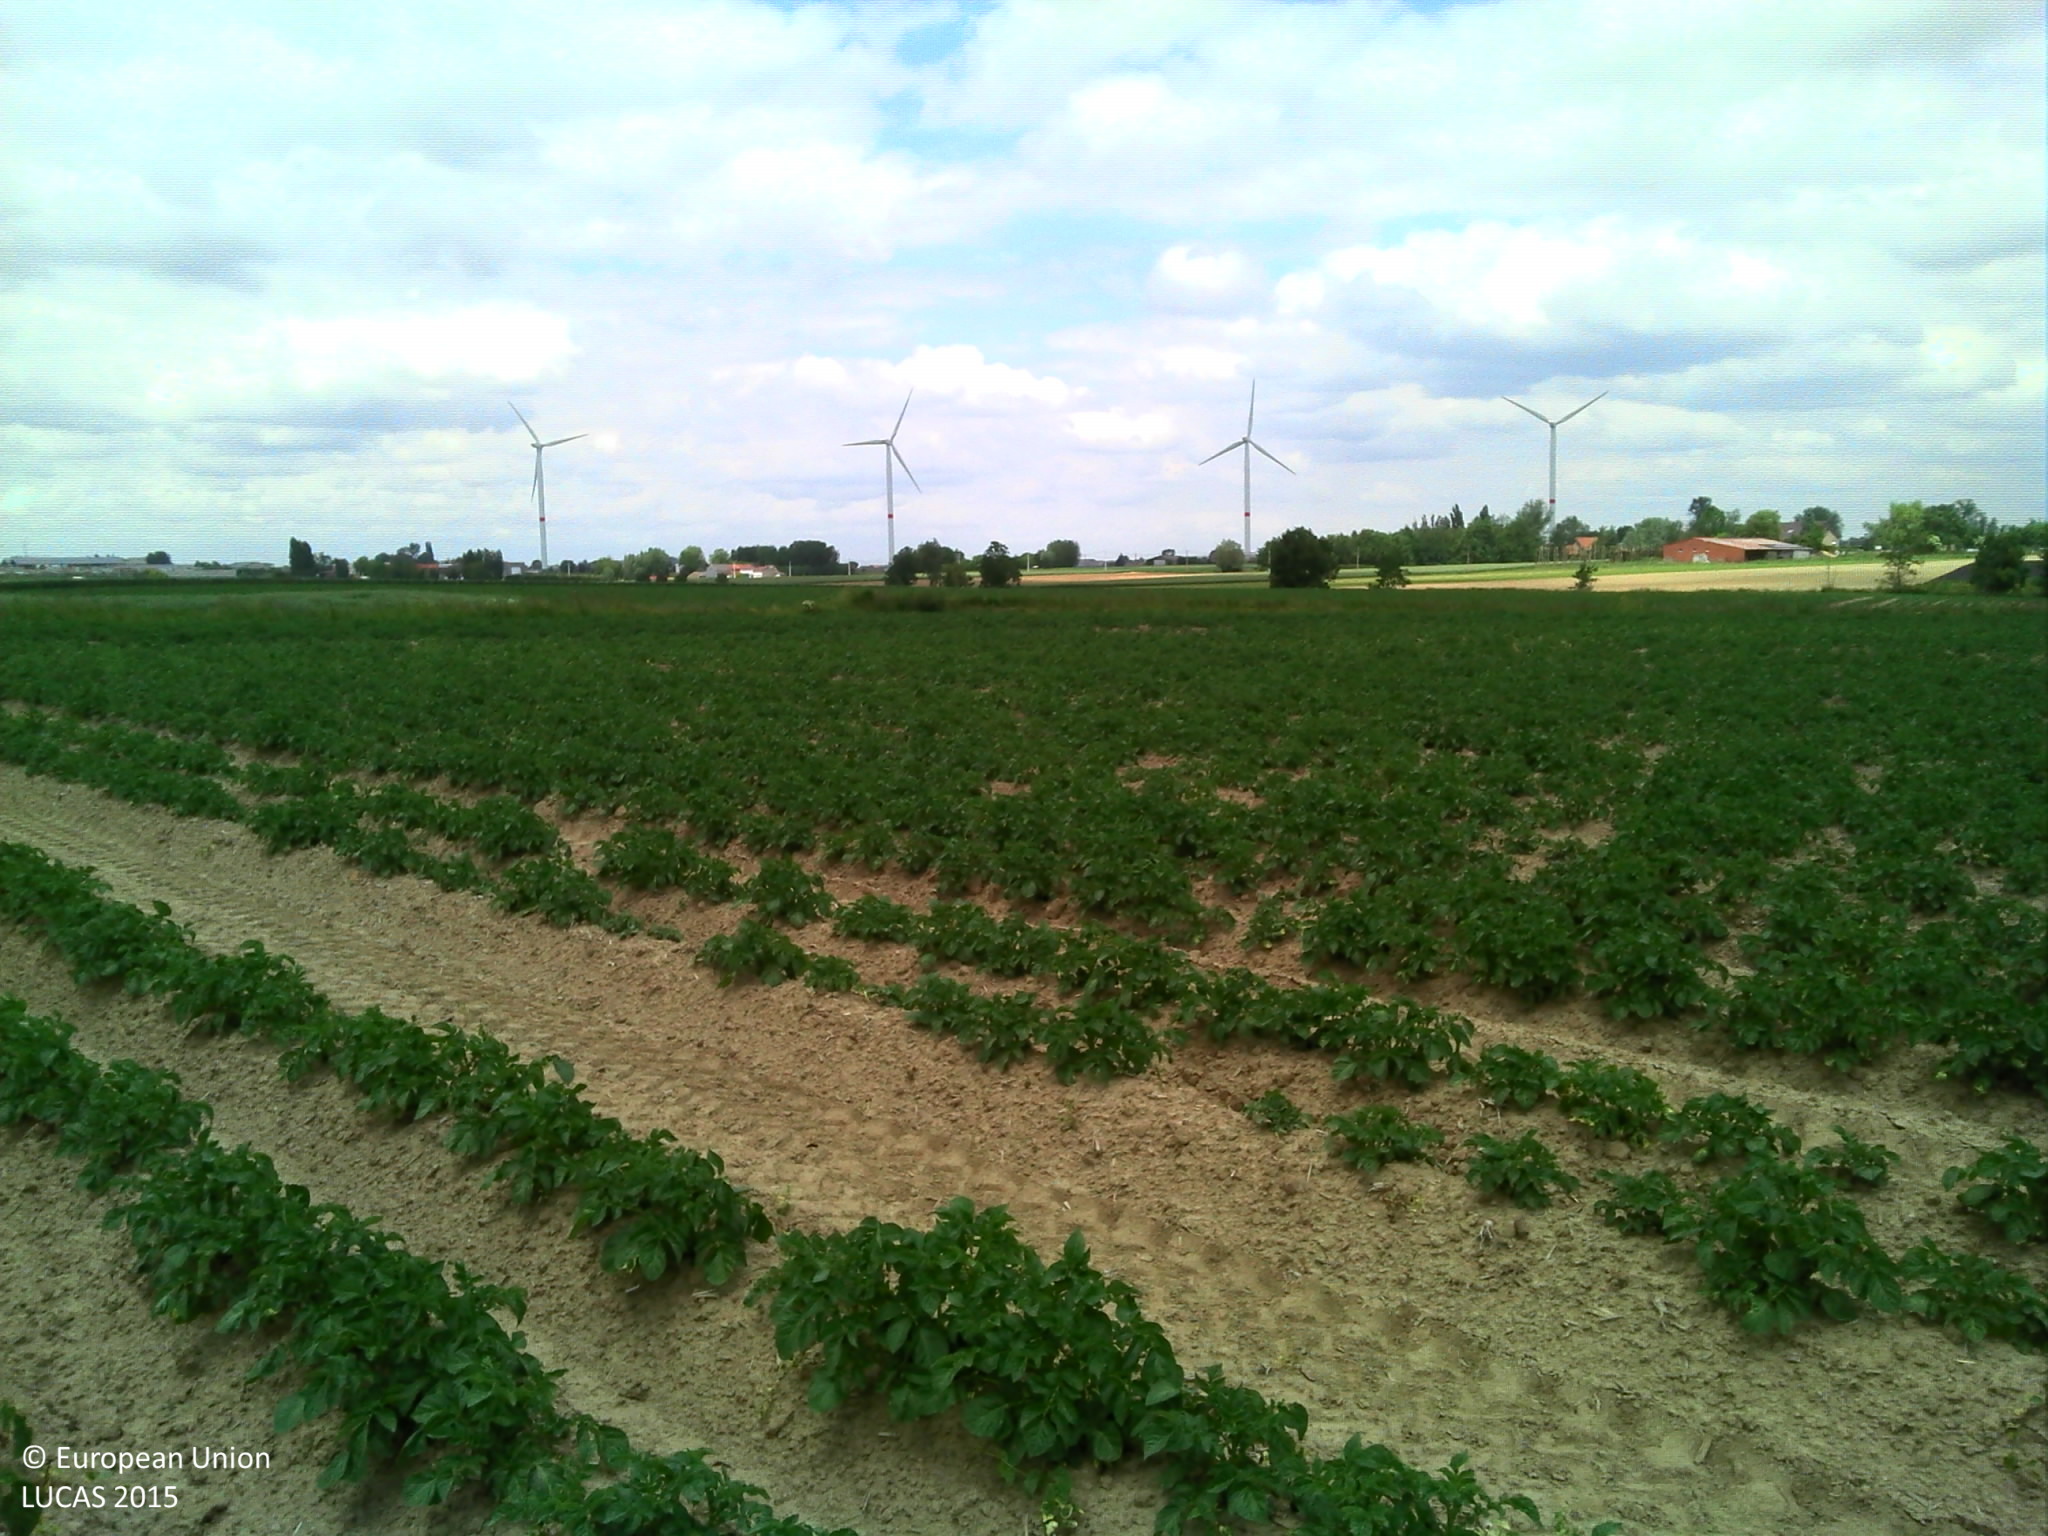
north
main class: Cropland
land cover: Potatoes
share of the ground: 10 - 25 %
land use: Agriculture (excluding fallow land and kitchen gardens)
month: June
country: BE
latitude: 50.8386
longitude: 2.7607
